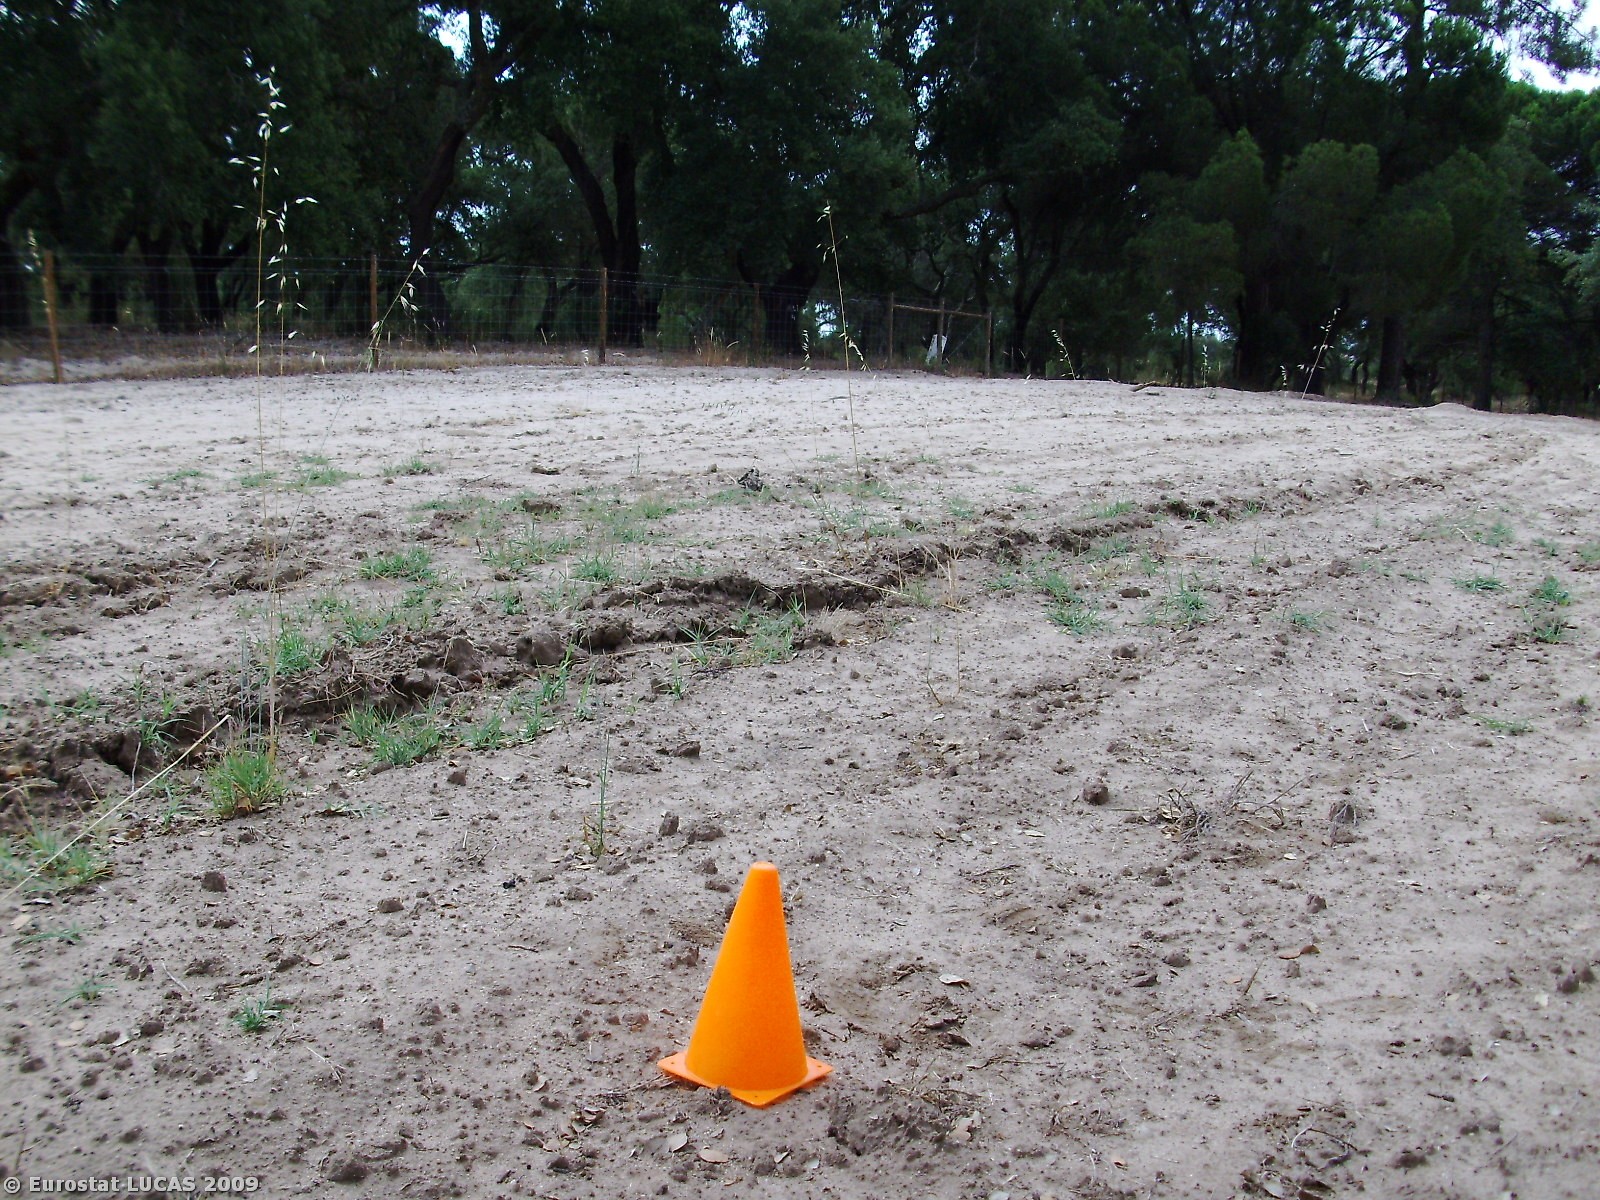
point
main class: Woodland
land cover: Broadleaved woodland
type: broadleaved evergreen forest
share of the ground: 10 - 25 %
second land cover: Bare land
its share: 10 - 25 %
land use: Forestry
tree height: > 5 m
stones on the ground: < 10 %
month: June
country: PT
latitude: 38.2976
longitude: -8.5395
